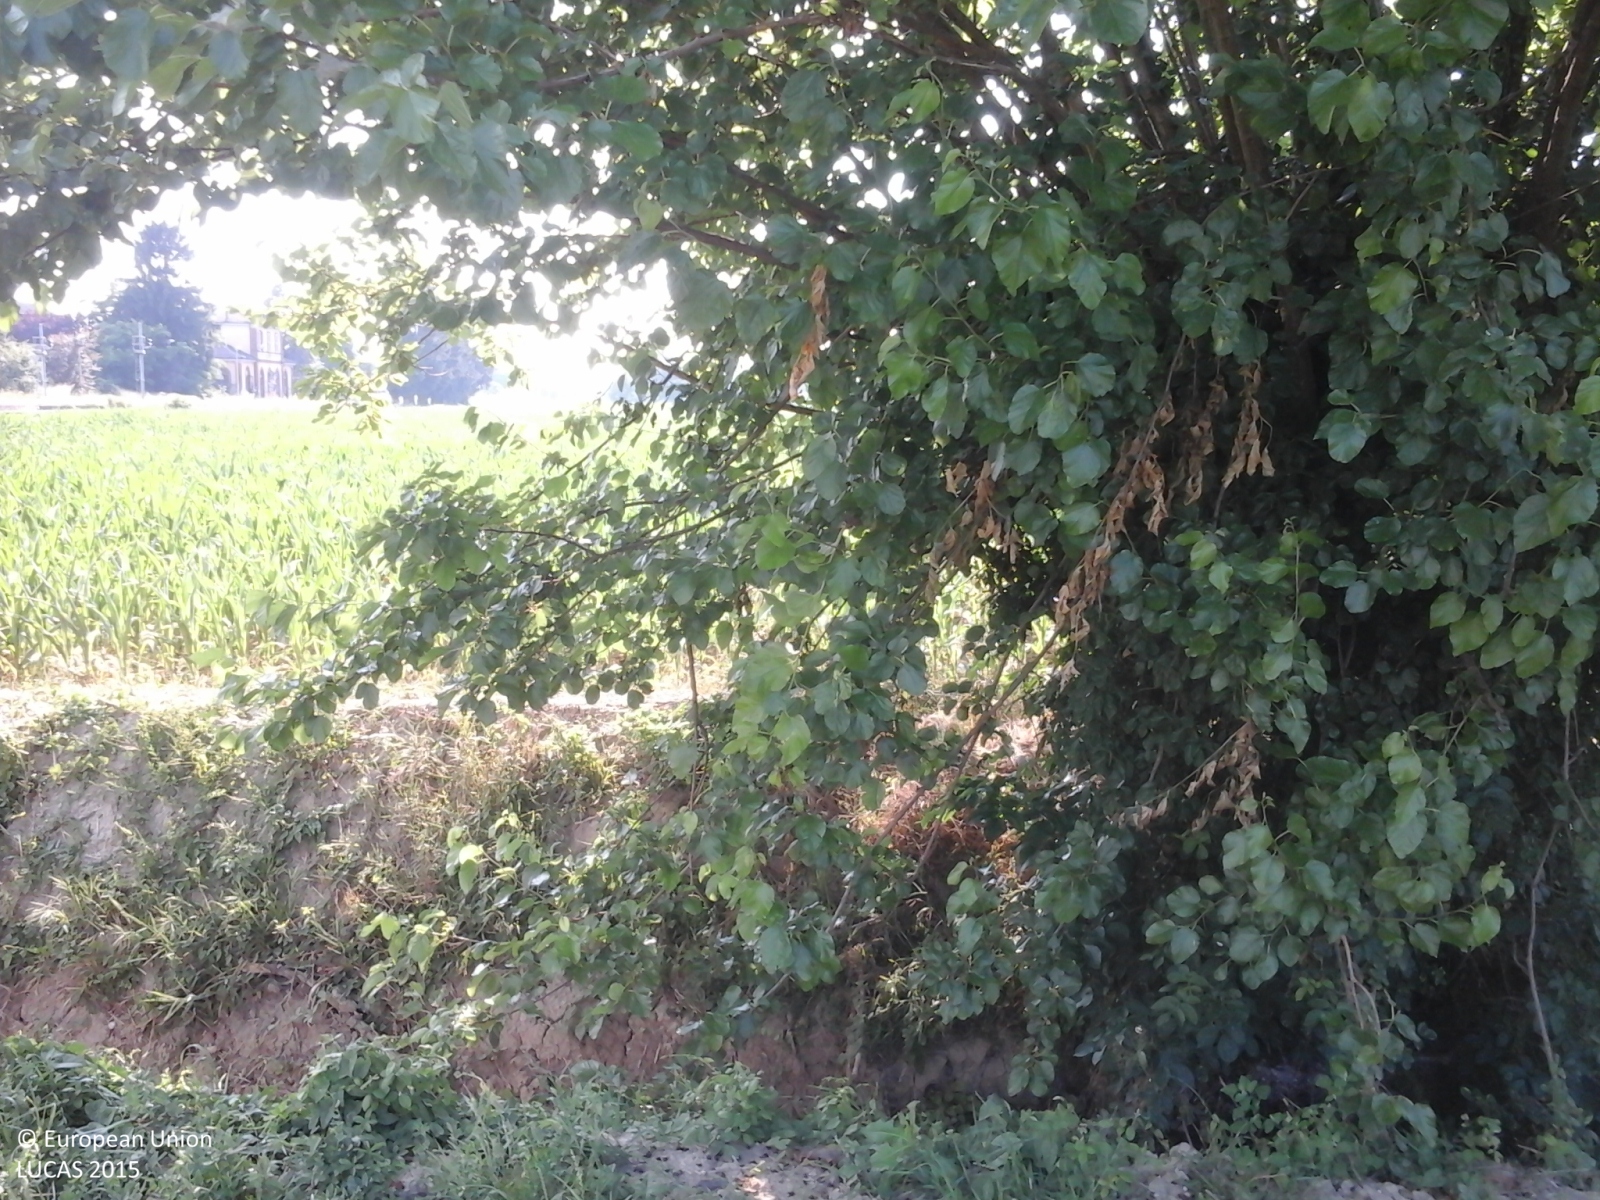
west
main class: Cropland
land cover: Rice
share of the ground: > 75 %
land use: Agriculture (excluding fallow land and kitchen gardens)
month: June
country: IT
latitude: 45.1601
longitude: 9.3778
